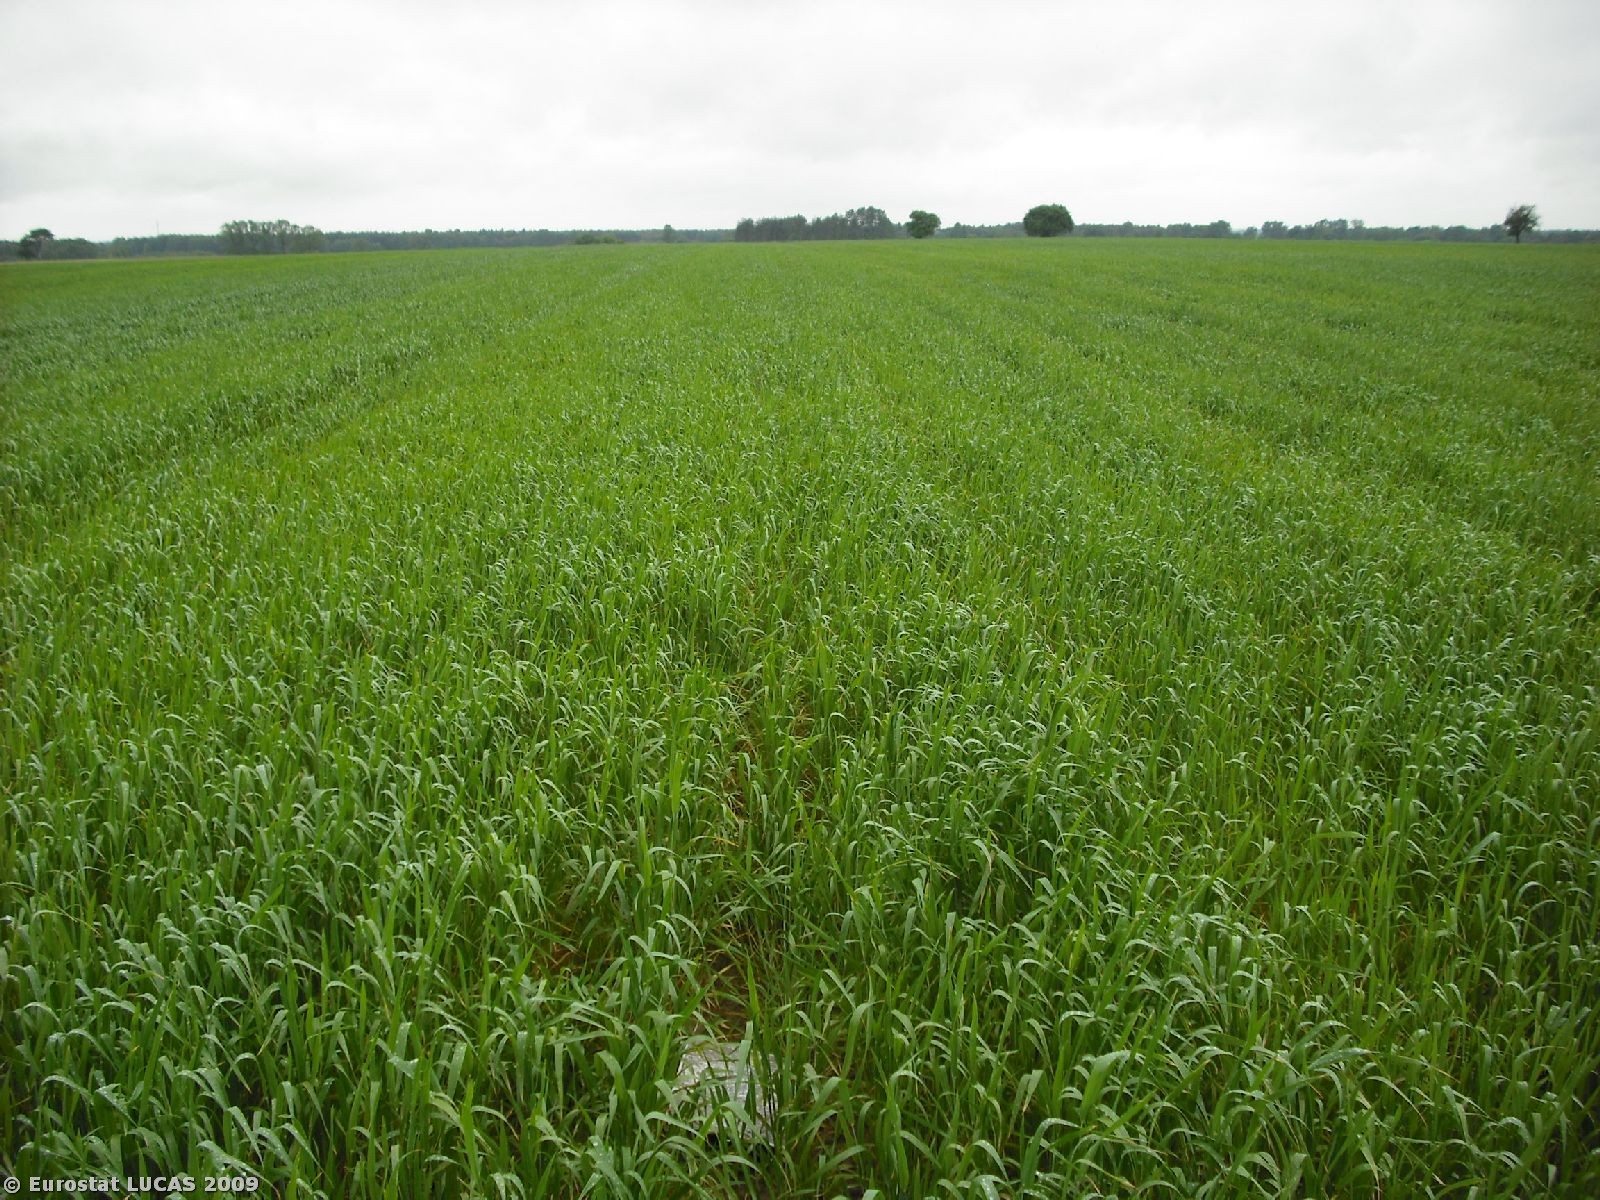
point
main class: Cropland
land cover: Oats
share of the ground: > 75 %
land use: Agriculture (excluding fallow land and kitchen gardens)
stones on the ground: < 10 %
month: June
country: PL
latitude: 52.6801
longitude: 23.3191
